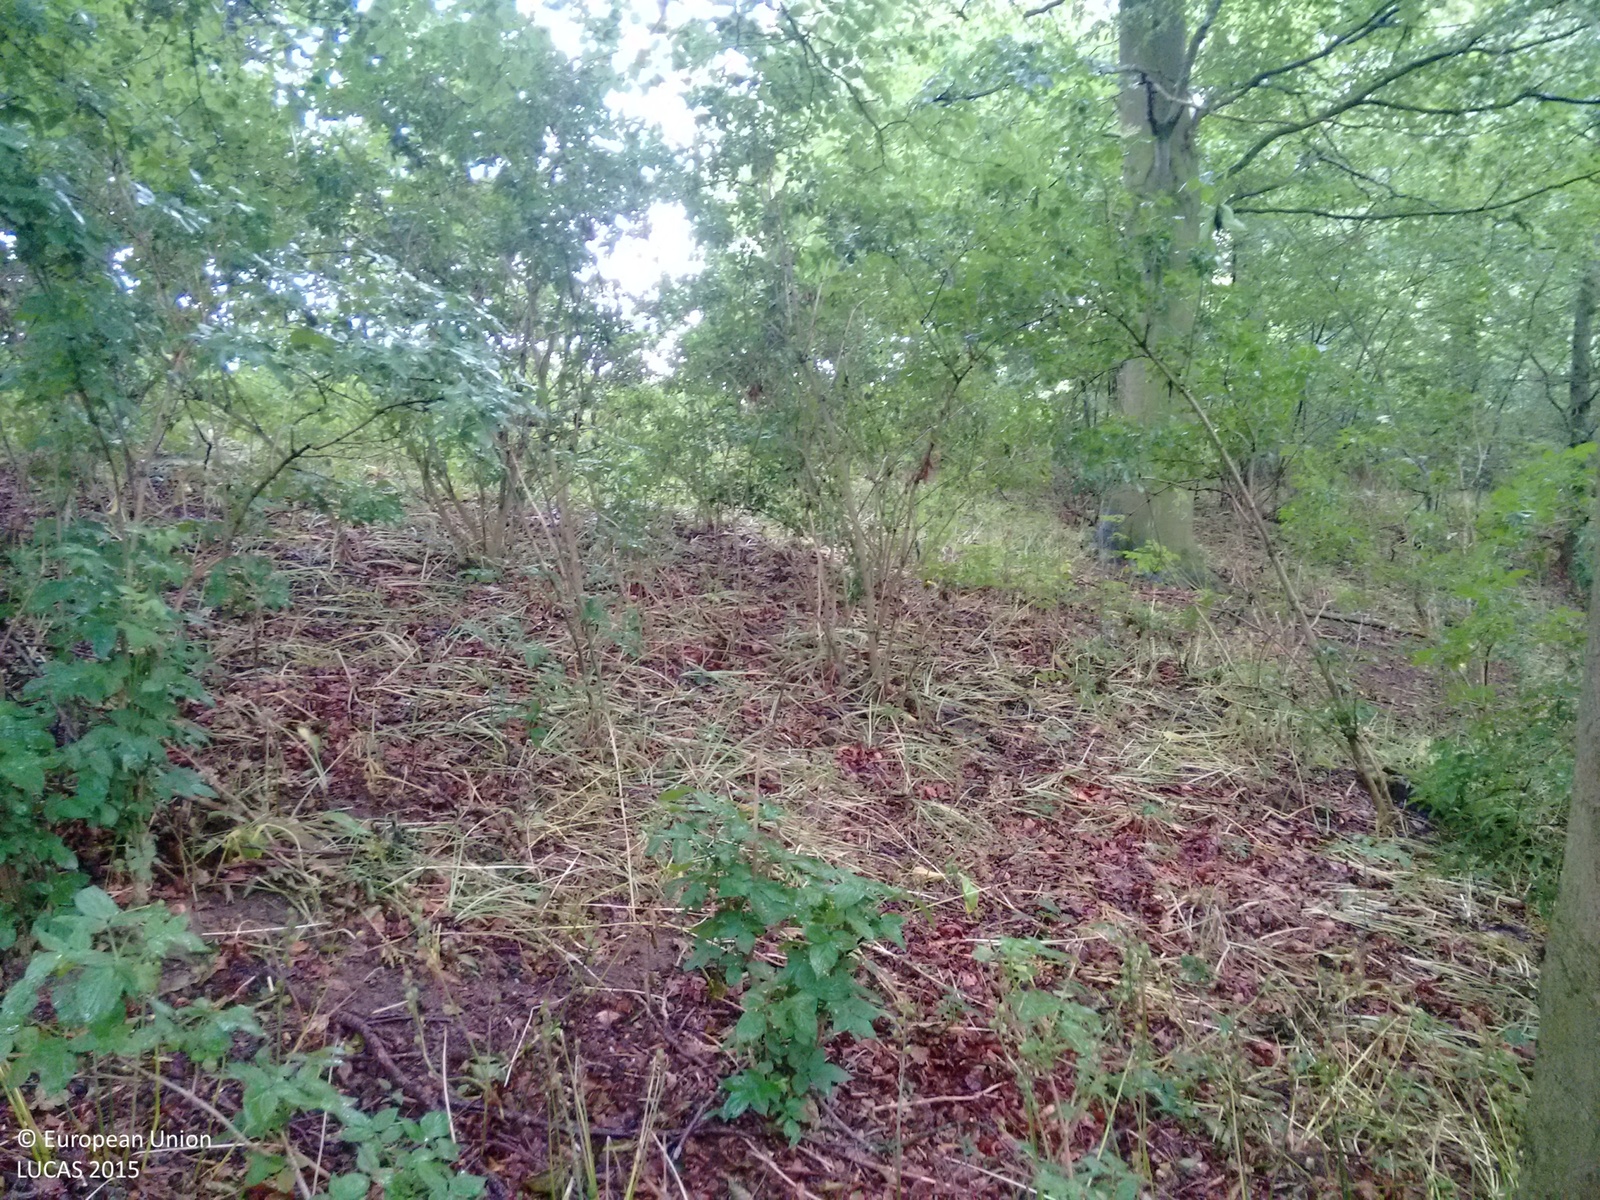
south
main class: Woodland
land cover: Broadleaved woodland
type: mesophytic deciduous forest
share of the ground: > 75 %
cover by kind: broadleaved forest trees 100 %
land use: Semi-natural and natural areas not in use
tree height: > 5 m
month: July
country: GB
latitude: 54.5540
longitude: -1.7566
